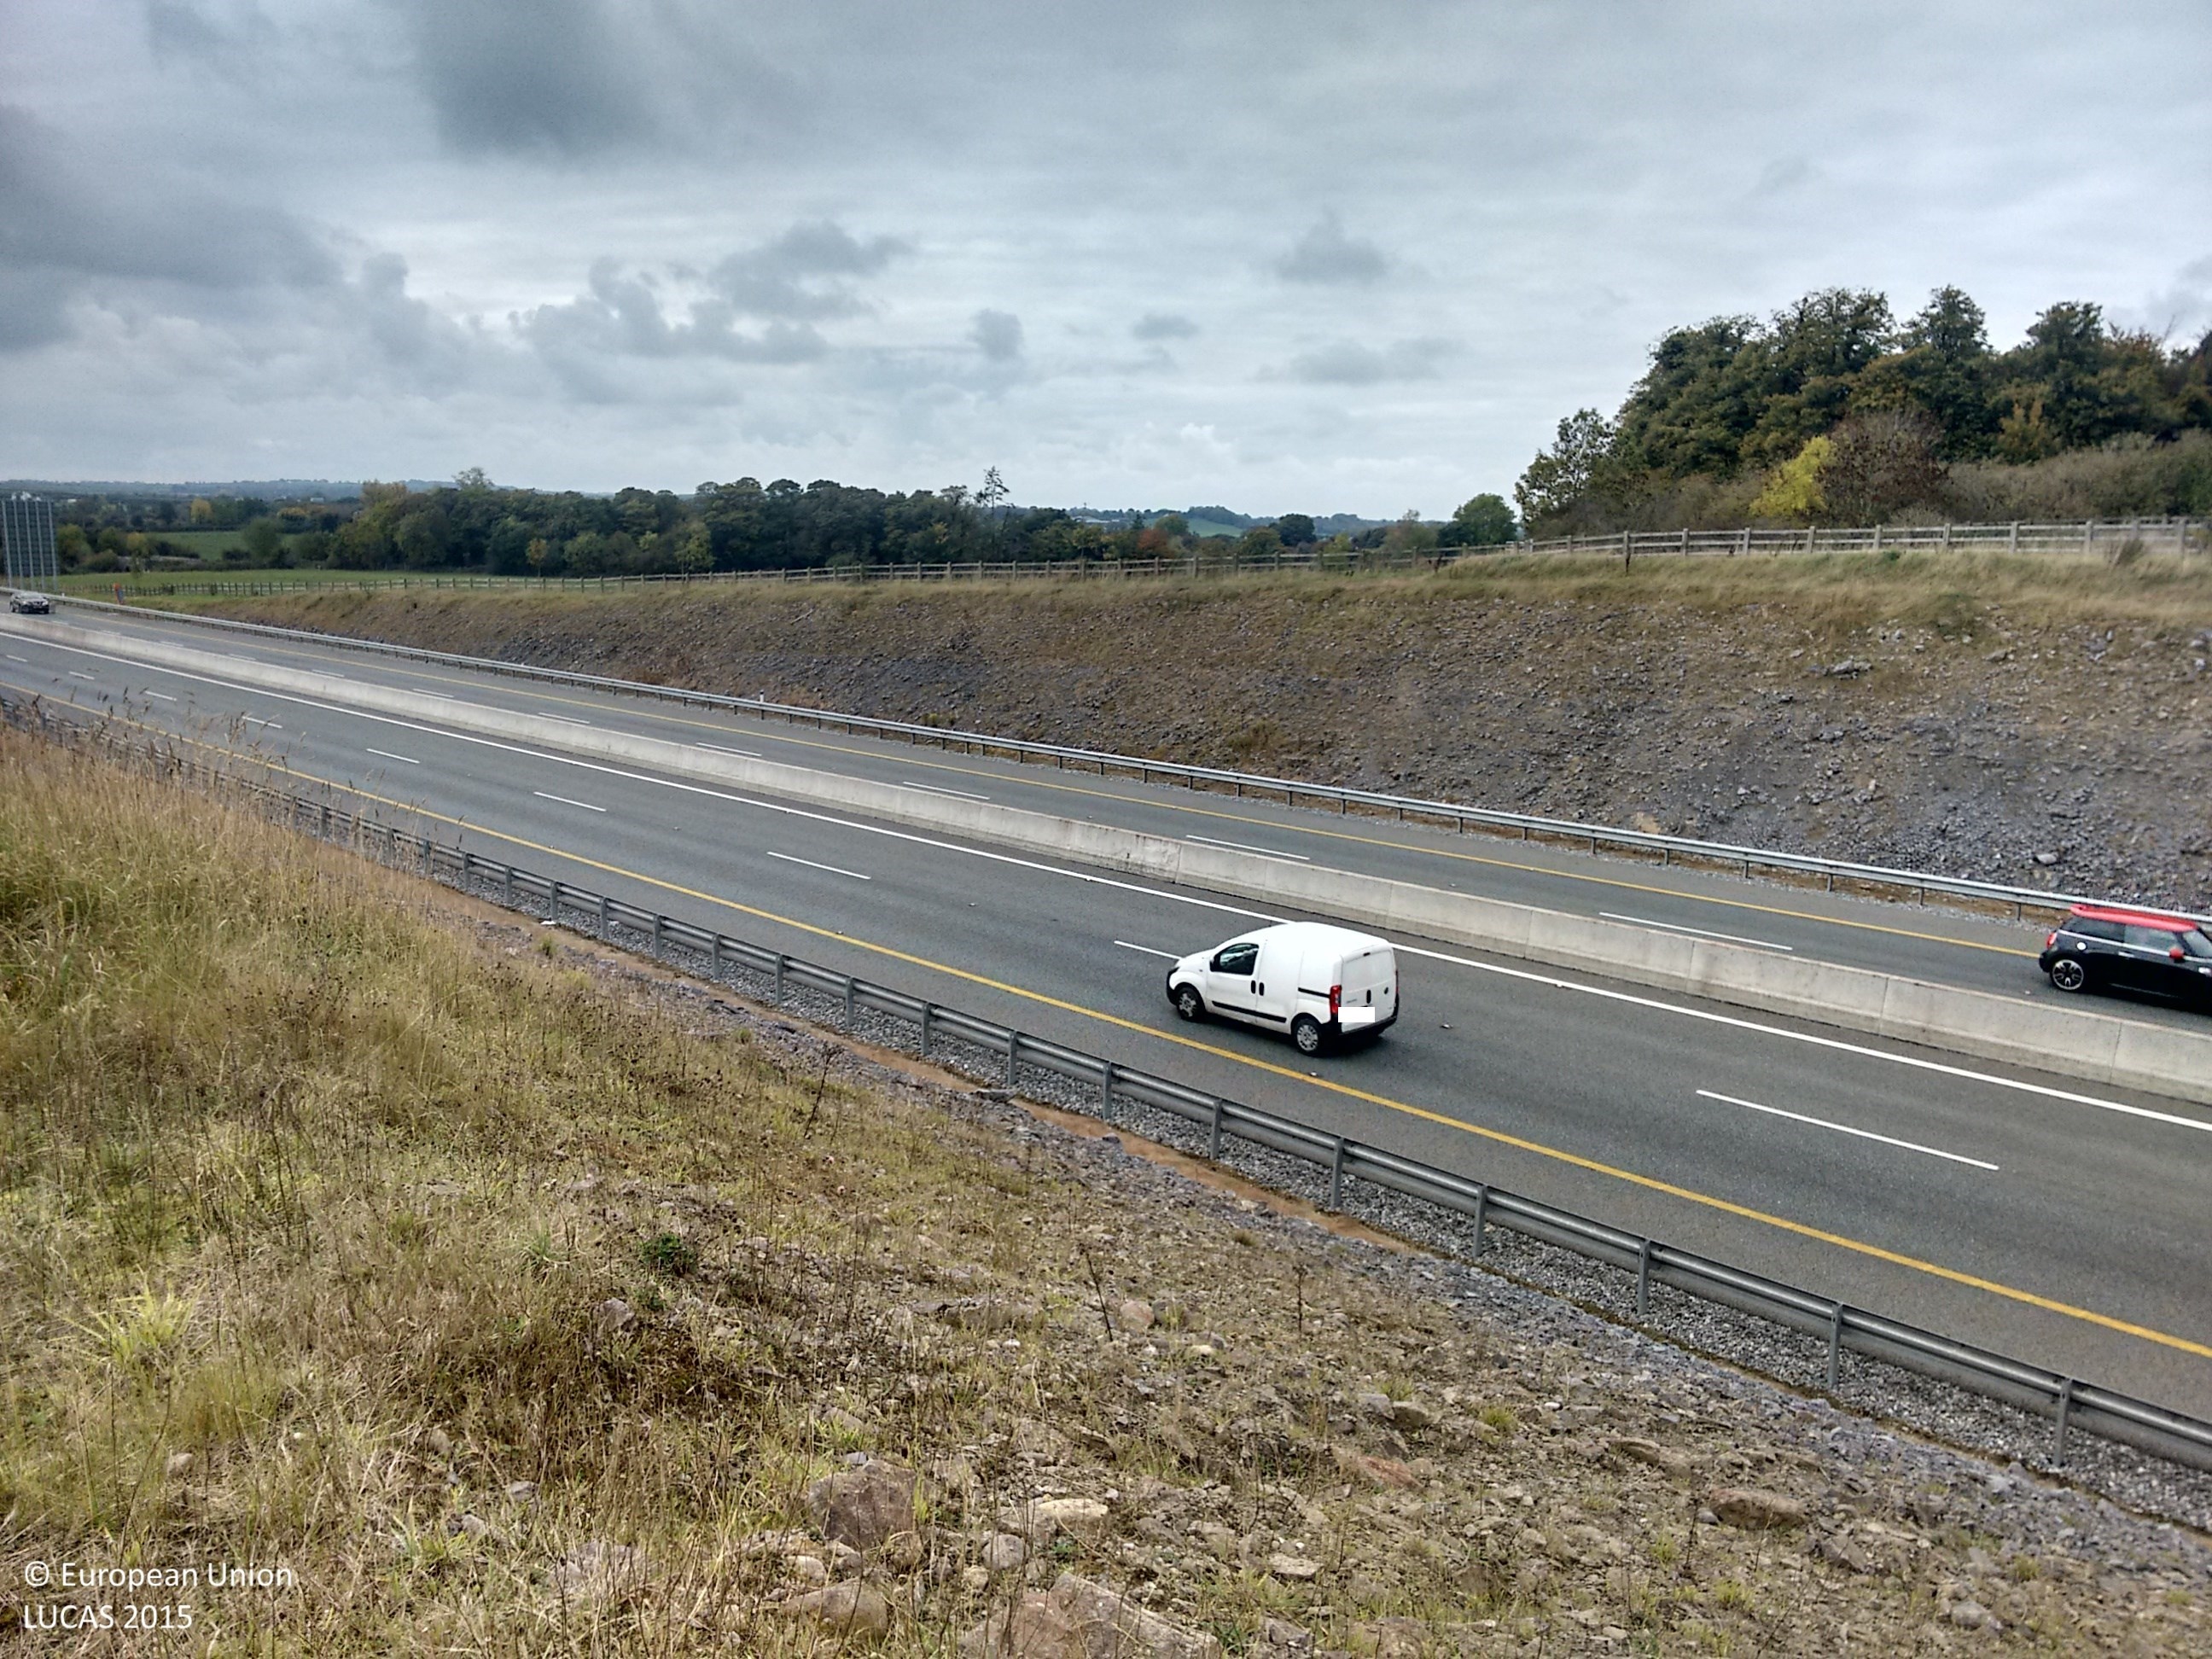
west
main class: Woodland
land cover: Broadleaved woodland
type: mesophytic deciduous forest
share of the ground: > 75 %
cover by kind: broadleaved forest trees 65 %, herbaceous plants 35 %
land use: Forestry
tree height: > 5 m
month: October
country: IE
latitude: 52.8515
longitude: -7.4879
